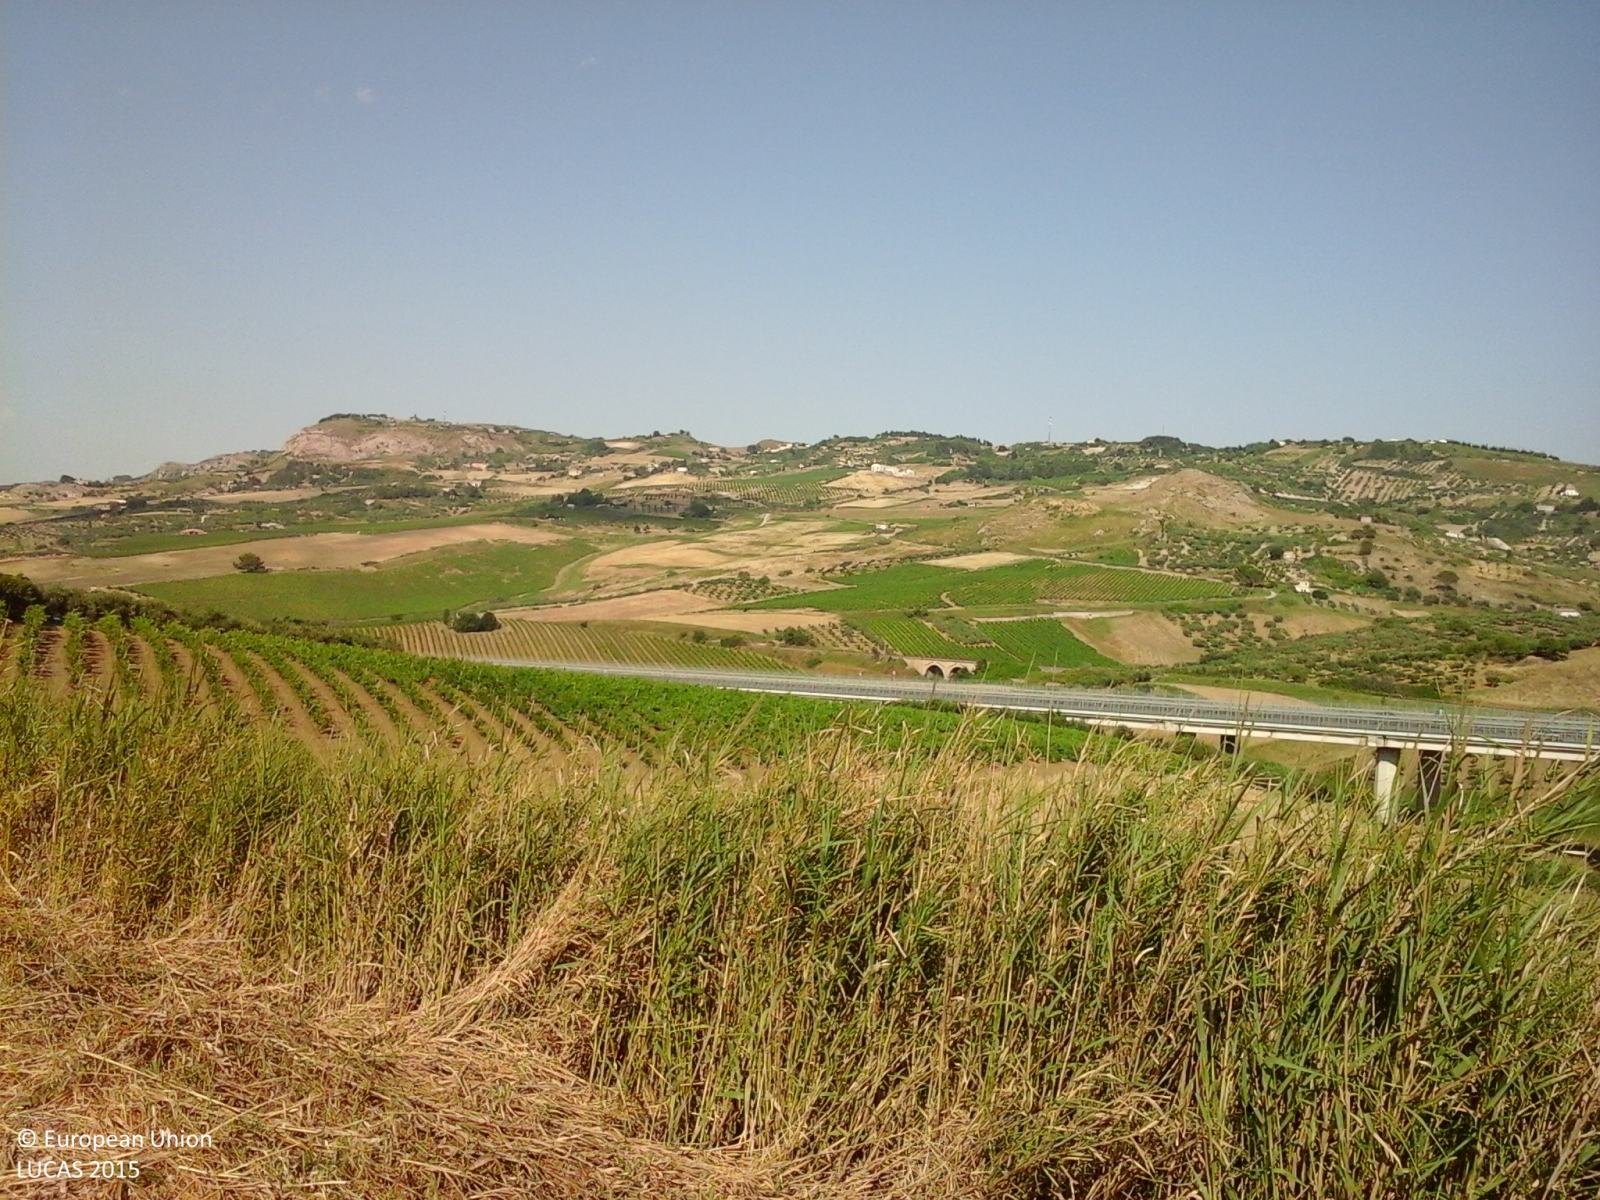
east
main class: Grassland
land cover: Grassland without tree/shrub cover
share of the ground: > 75 %
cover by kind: herbaceous plants 100 %
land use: Agriculture (excluding fallow land and kitchen gardens)
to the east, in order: Grassland without tree/shrub cover; Durum wheat; Vineyards; Olive groves
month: June
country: IT
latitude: 37.7775
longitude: 12.8513
